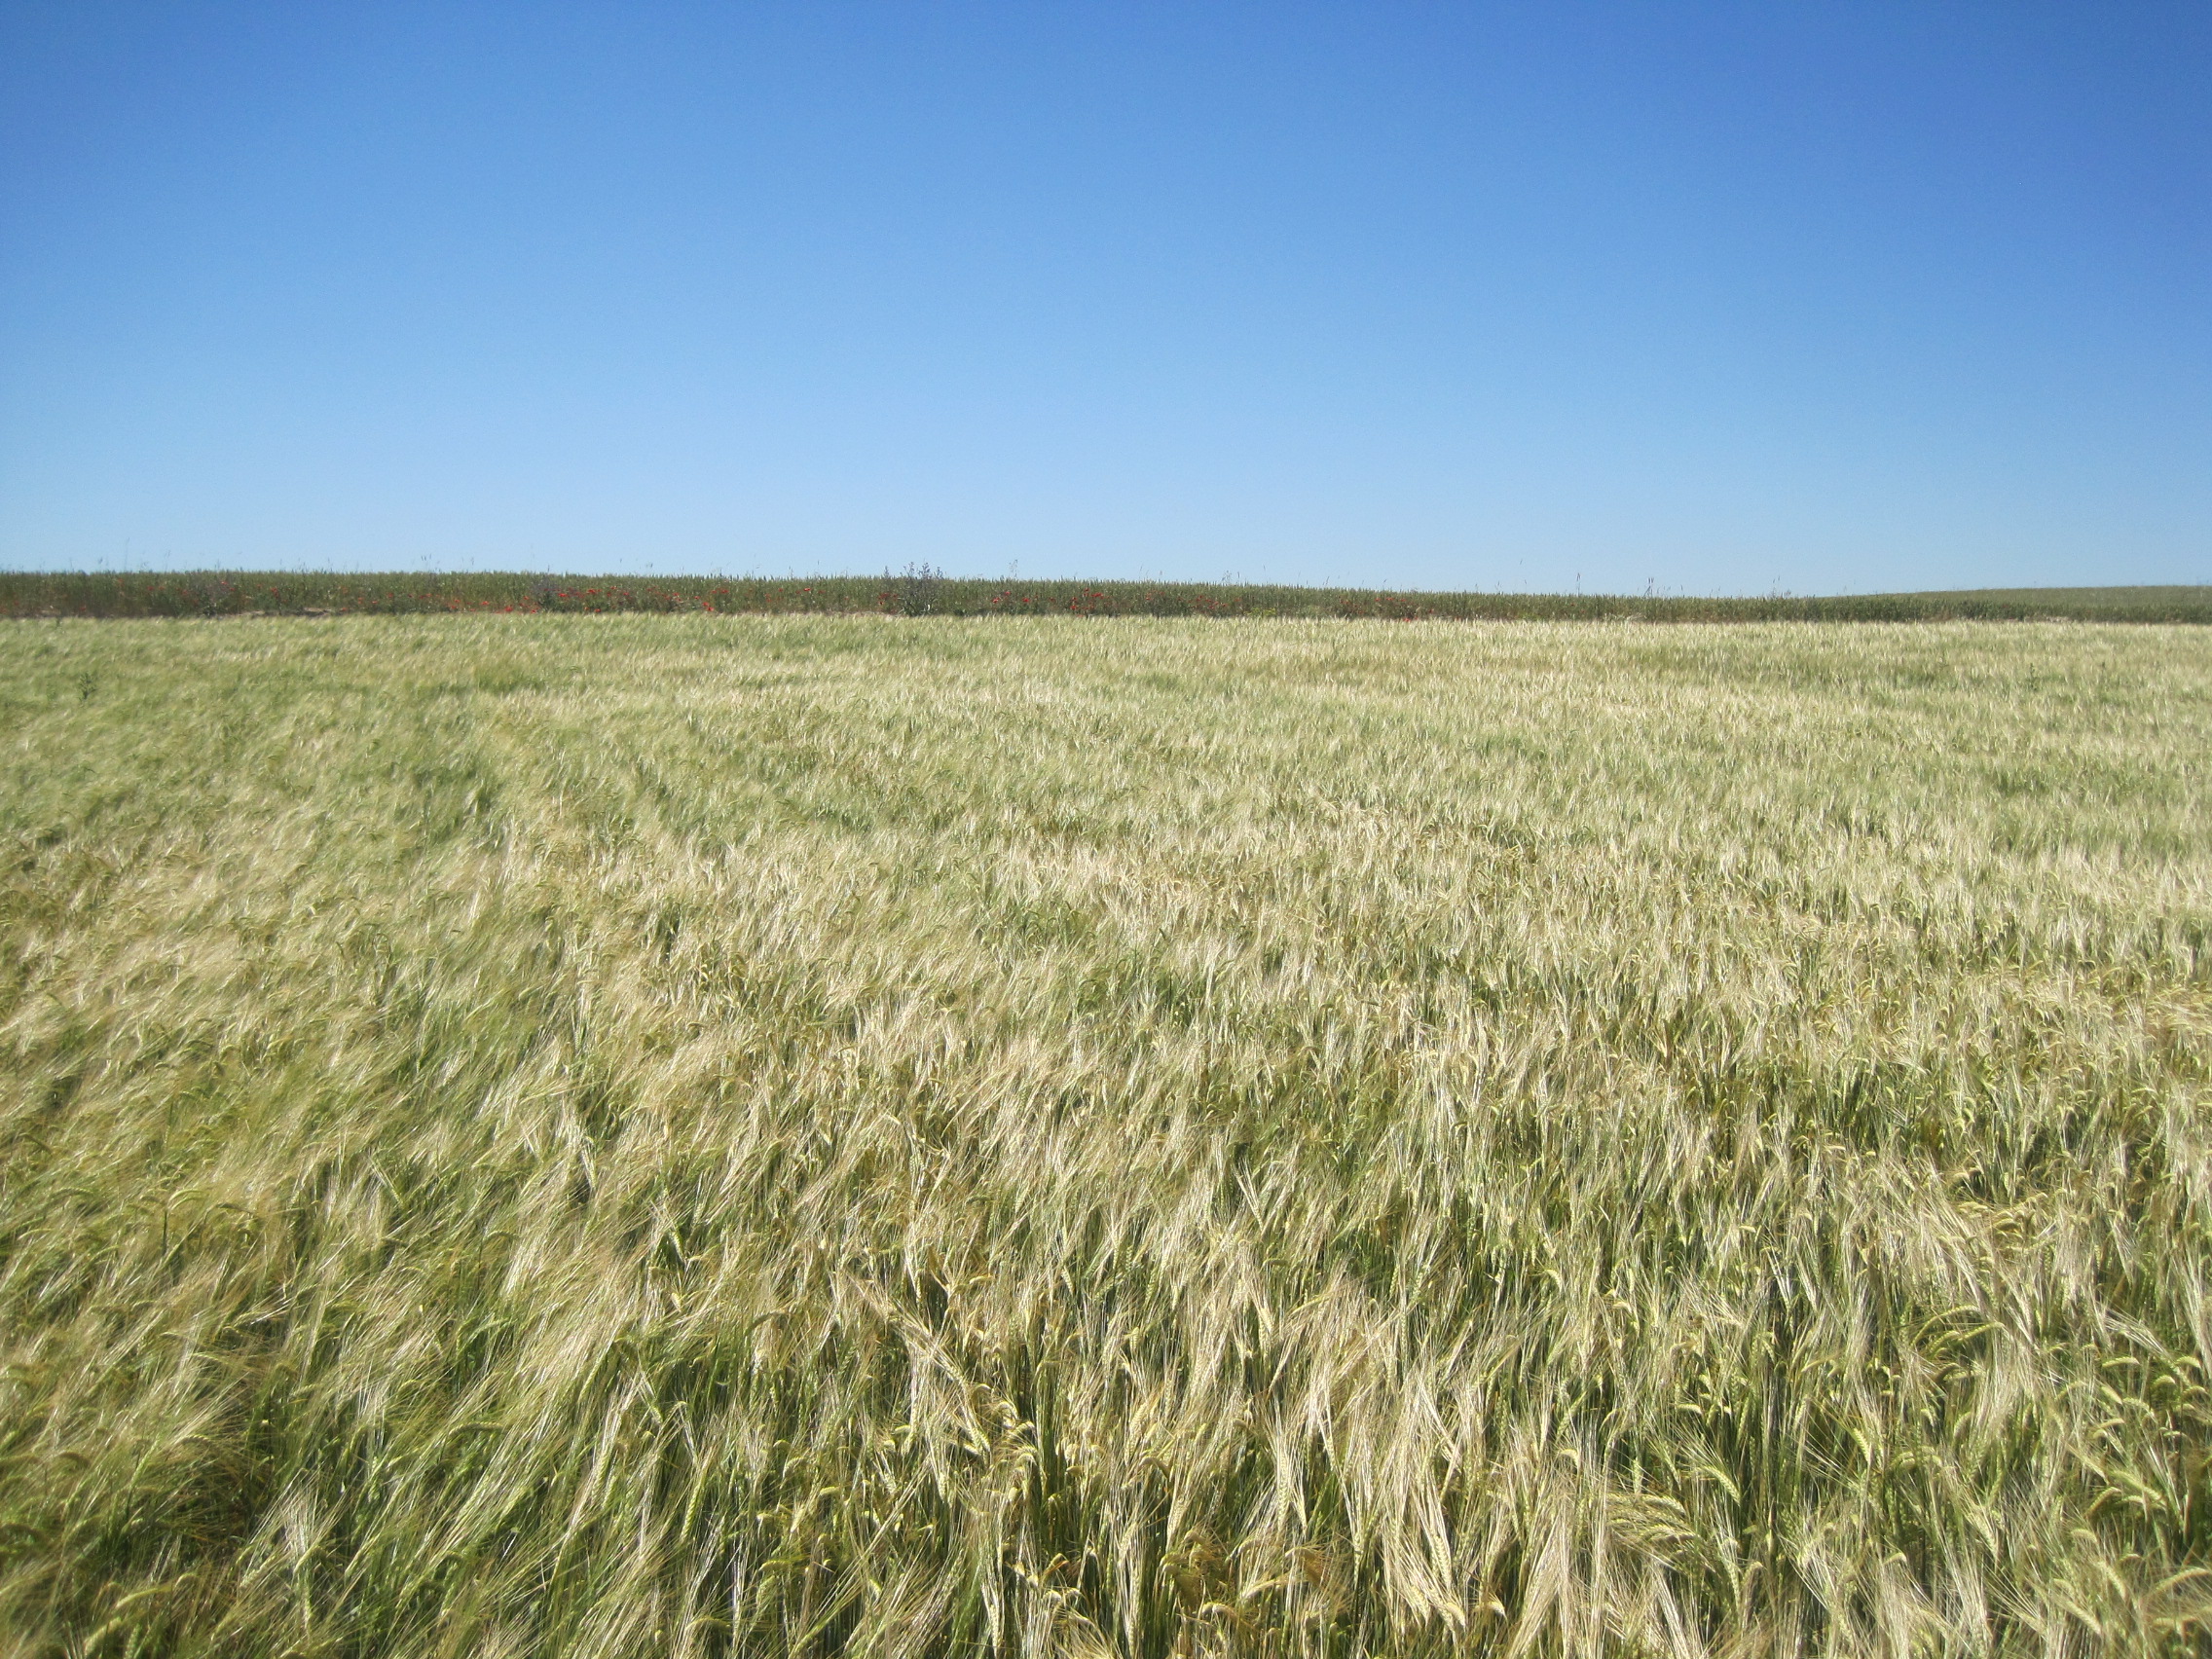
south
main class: Cropland
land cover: Barley
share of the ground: > 75 %
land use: Agriculture (excluding fallow land and kitchen gardens)
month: May
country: ES
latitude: 41.2822
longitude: -5.2976
